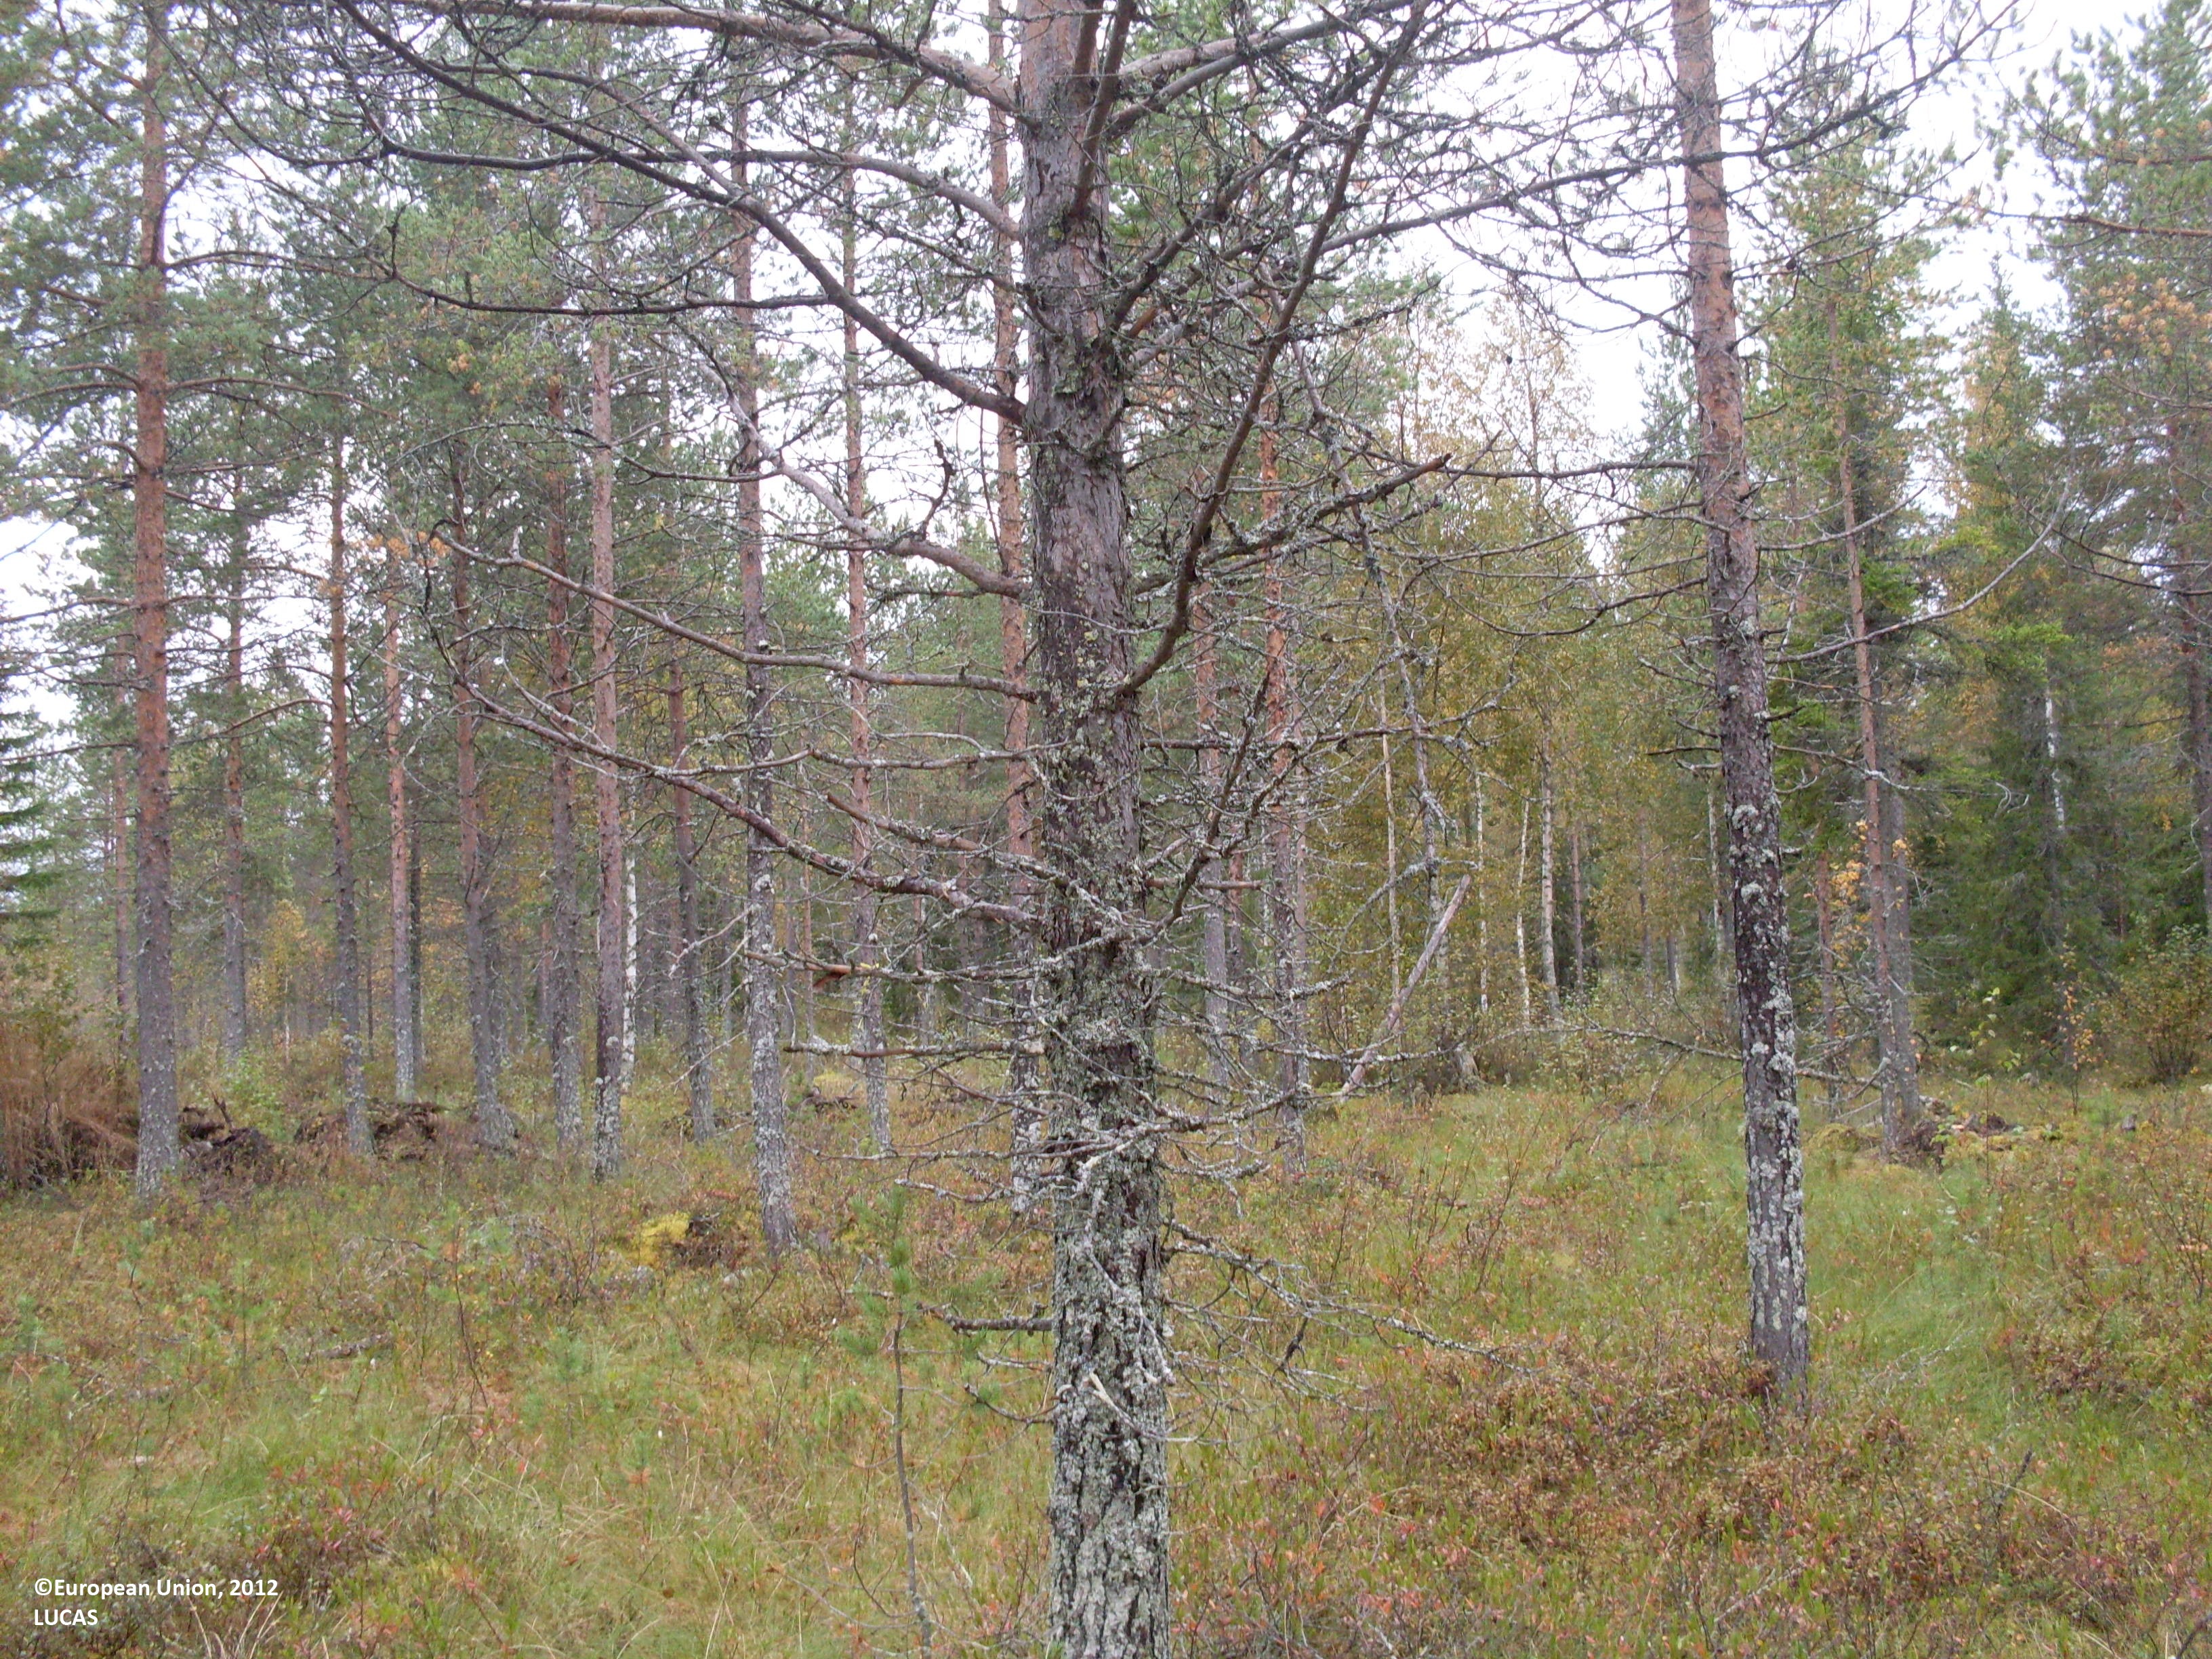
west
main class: Woodland
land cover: Other coniferous woodland
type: boreal forest
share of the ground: 50 - 75 %
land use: Forestry
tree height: > 5 m
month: September
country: FI
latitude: 64.0836
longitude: 30.2448
